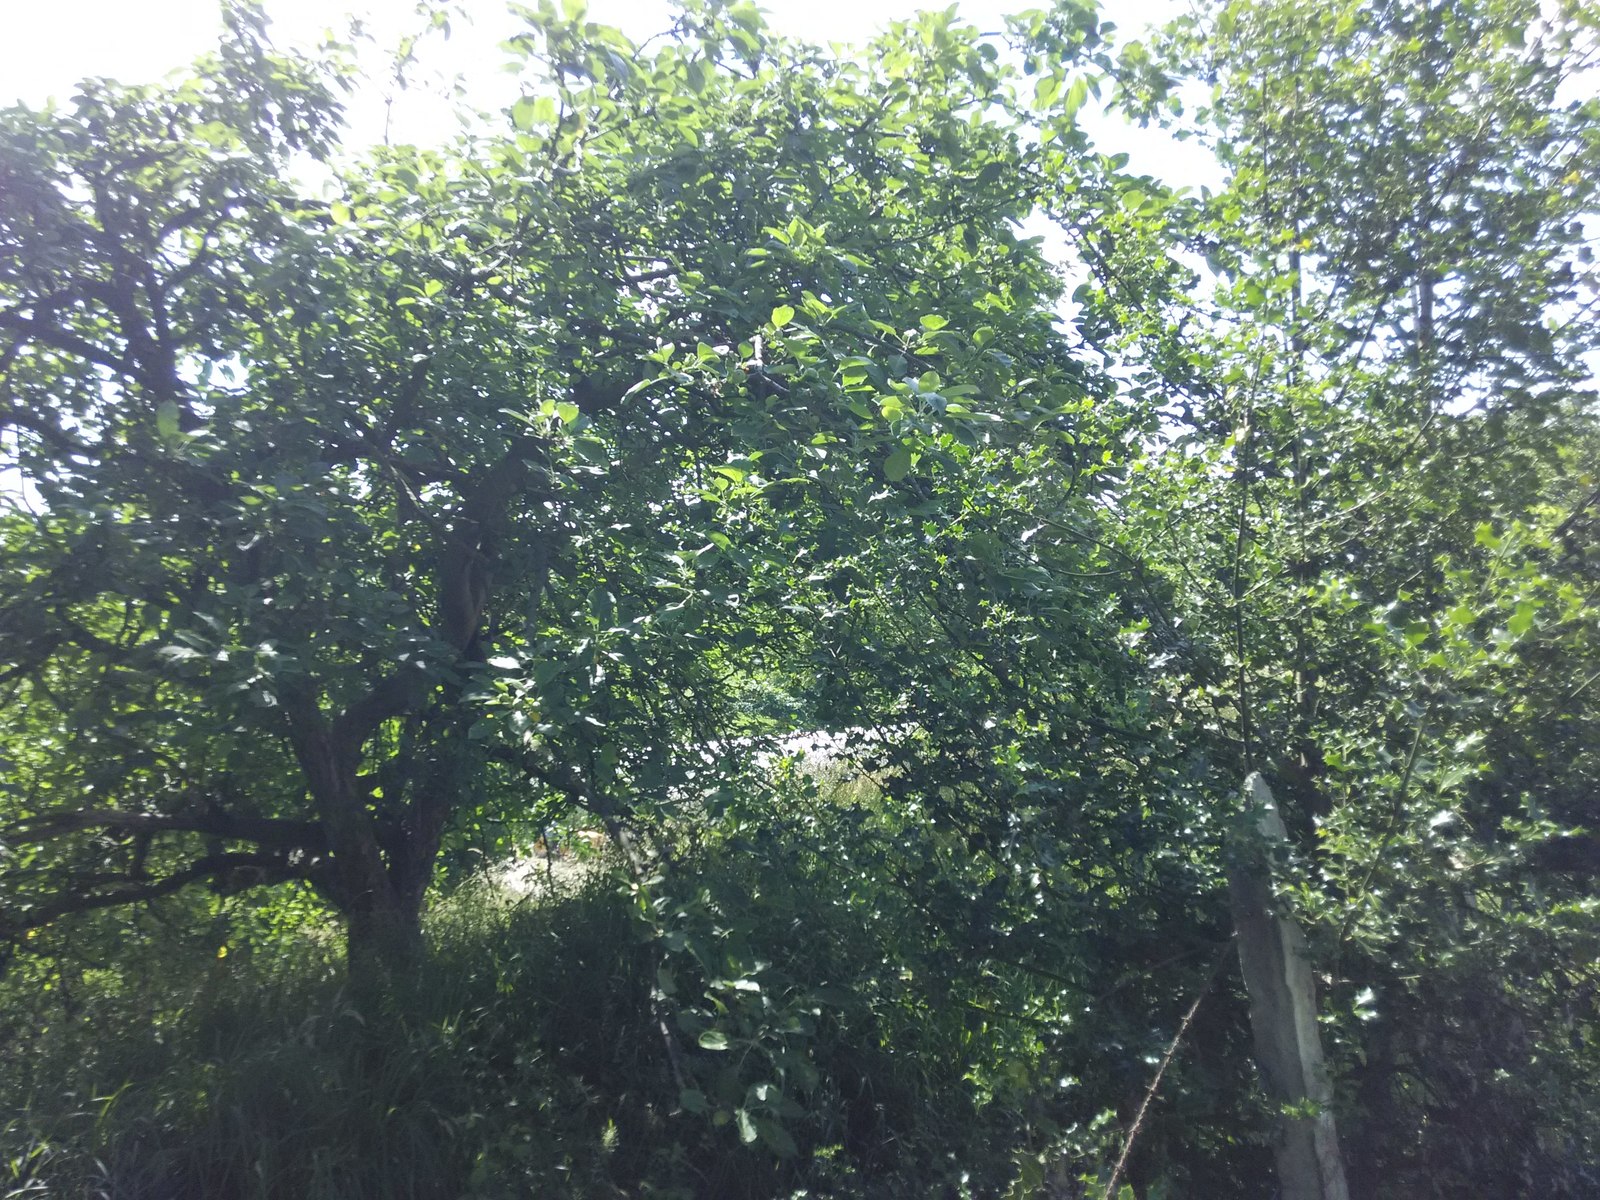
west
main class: Woodland
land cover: Broadleaved woodland
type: acidophilous oak and oak-birch forest
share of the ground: > 75 %
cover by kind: broadleaved forest trees 95 %, herbaceous plants 5 %
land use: Forestry
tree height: > 5 m
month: June
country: ES
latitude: 43.3204
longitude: -1.8713
